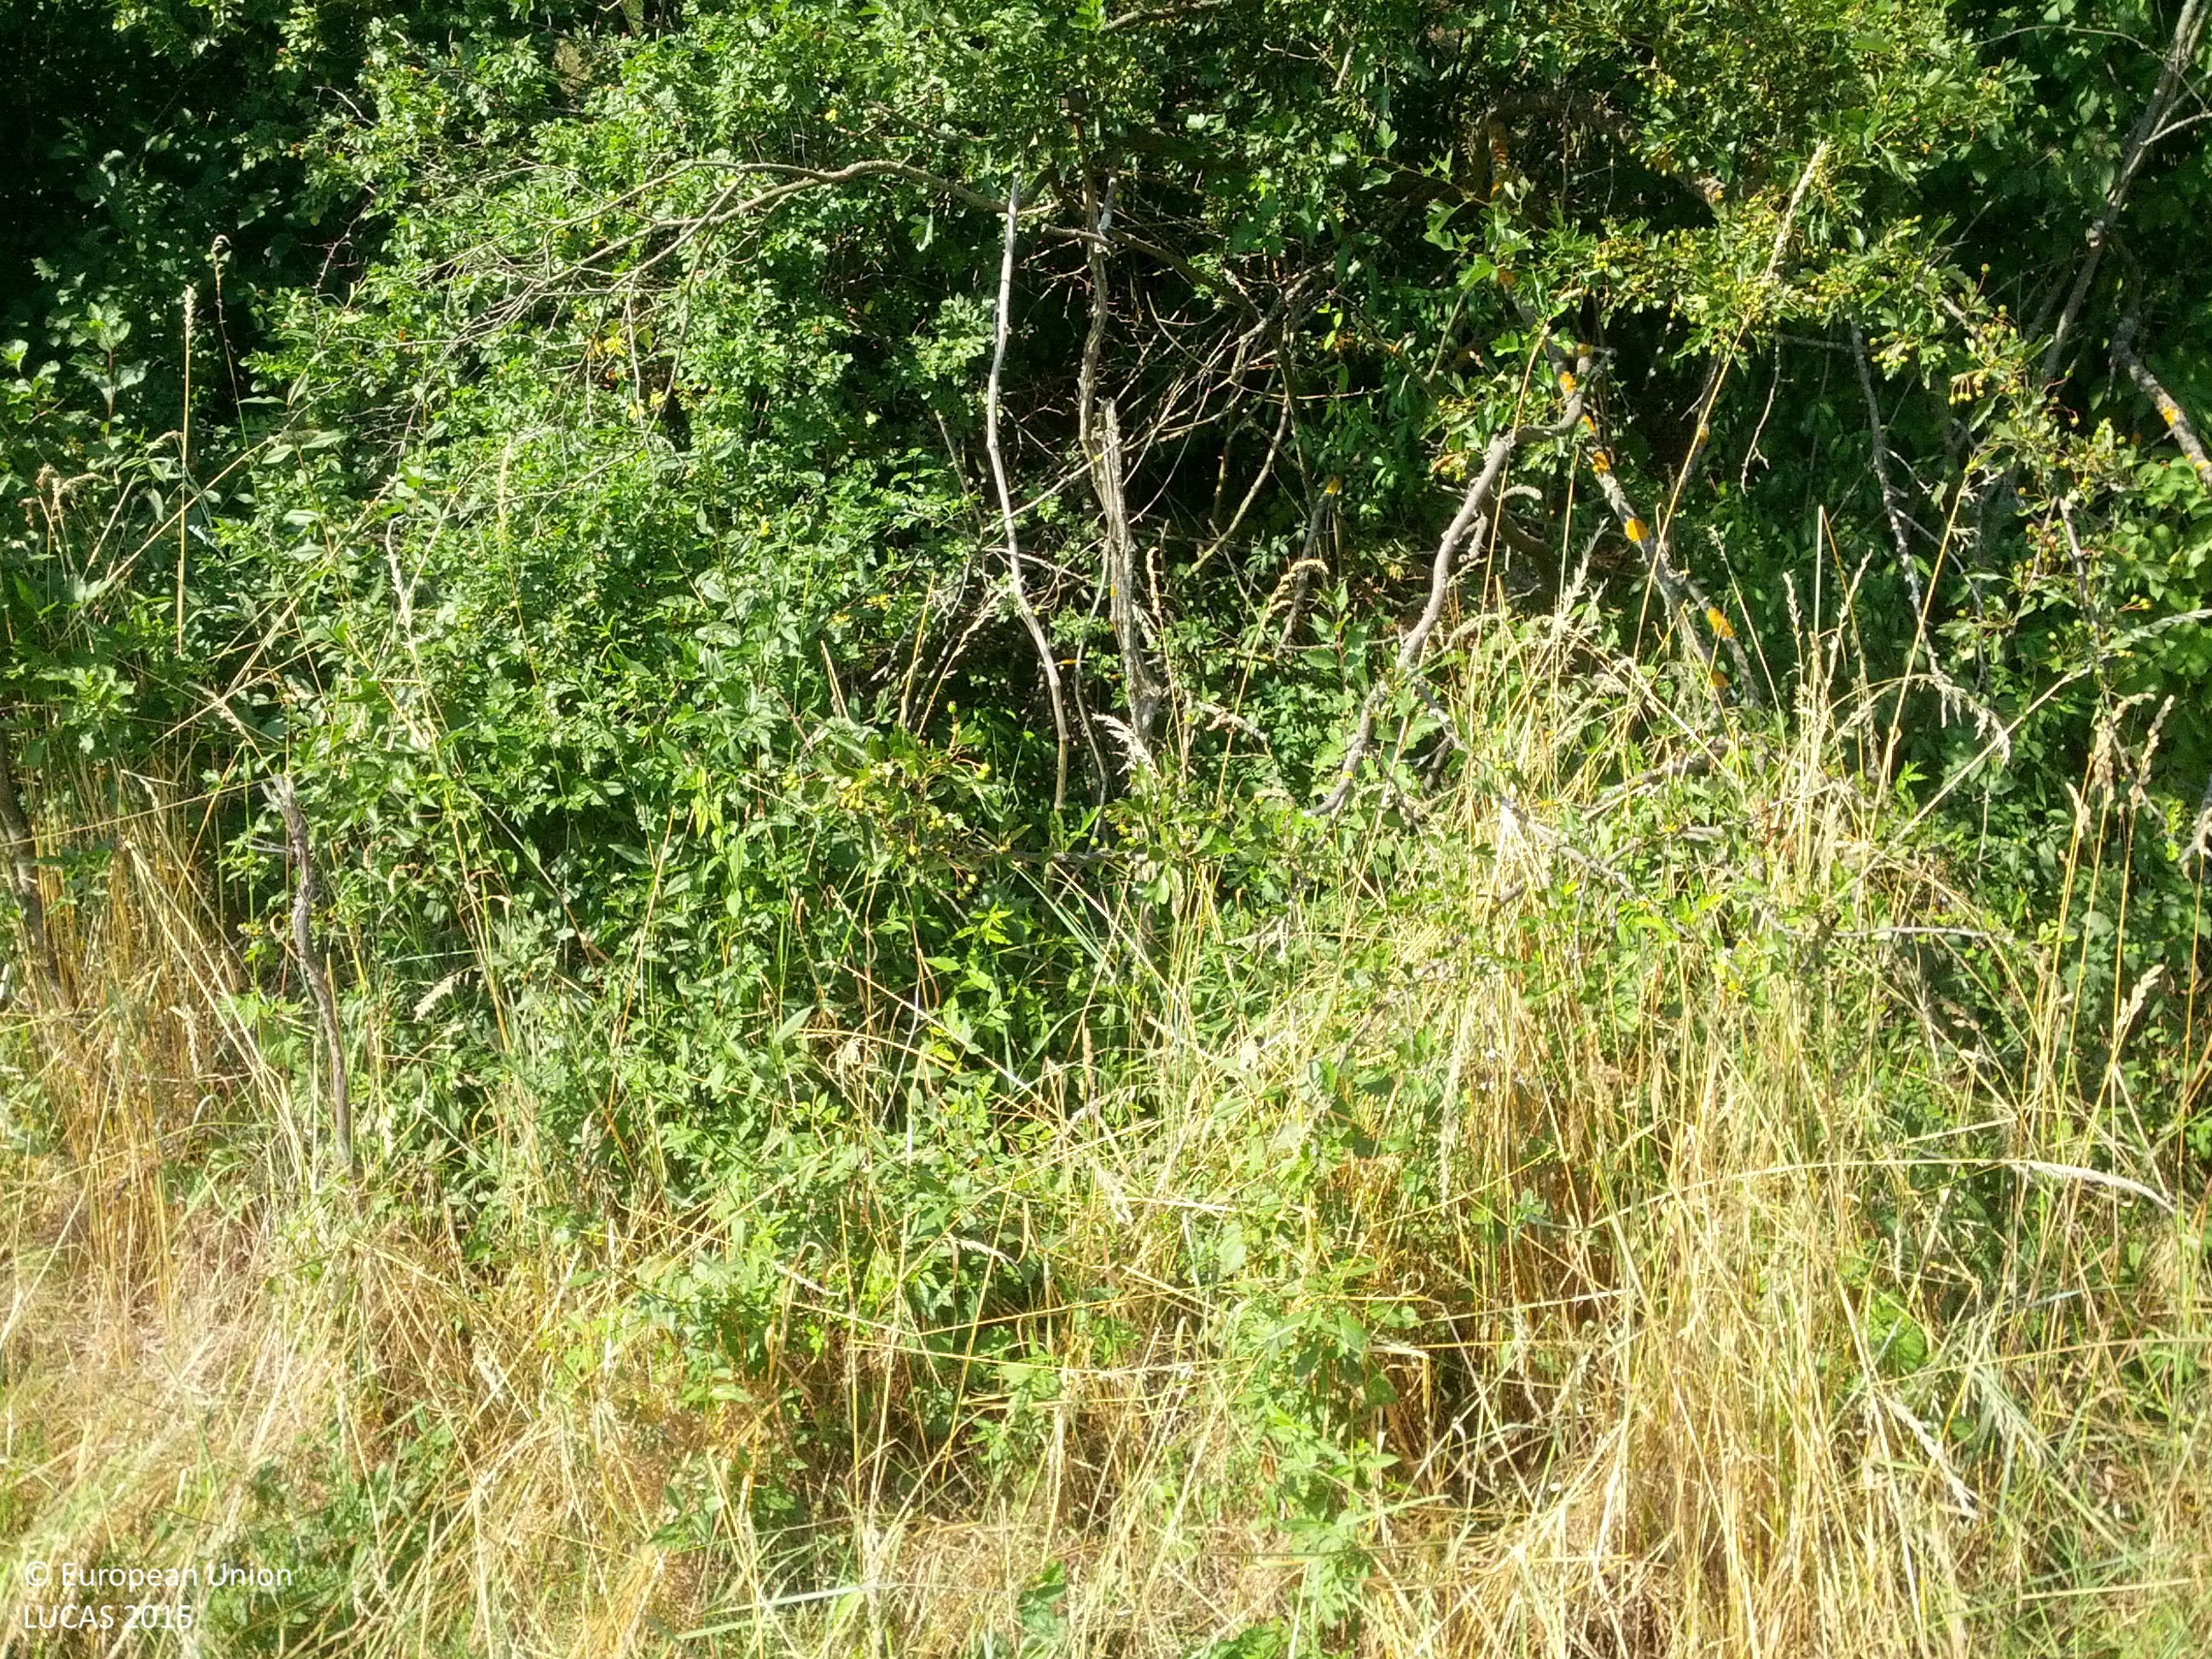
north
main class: Grassland
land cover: Grassland without tree/shrub cover
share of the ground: > 75 %
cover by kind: herbaceous plants 100 %
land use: Agriculture (excluding fallow land and kitchen gardens)
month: July
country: AT
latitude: 48.5083
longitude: 16.6800
